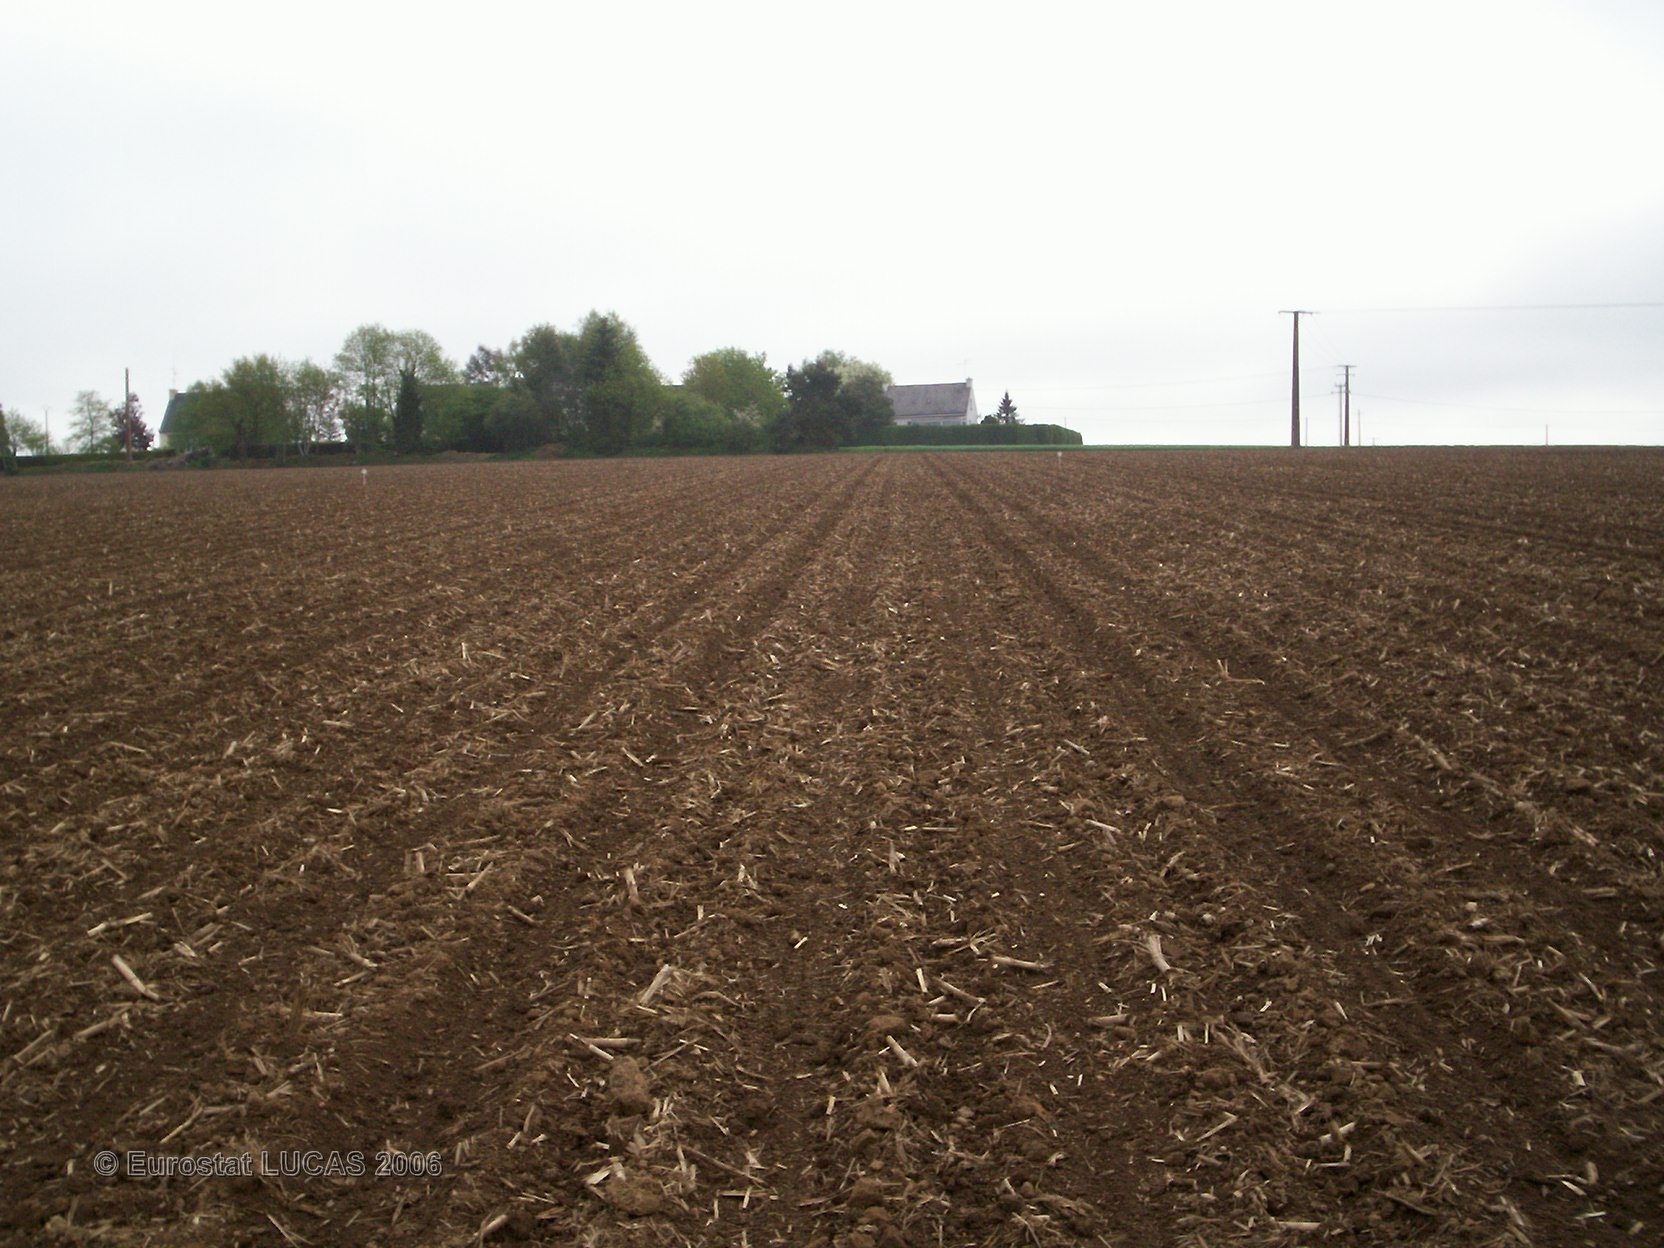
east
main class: Cropland
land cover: Maize
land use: Agriculture (excluding fallow land and kitchen gardens)
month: May
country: FR
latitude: 48.1297
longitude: -2.9529
